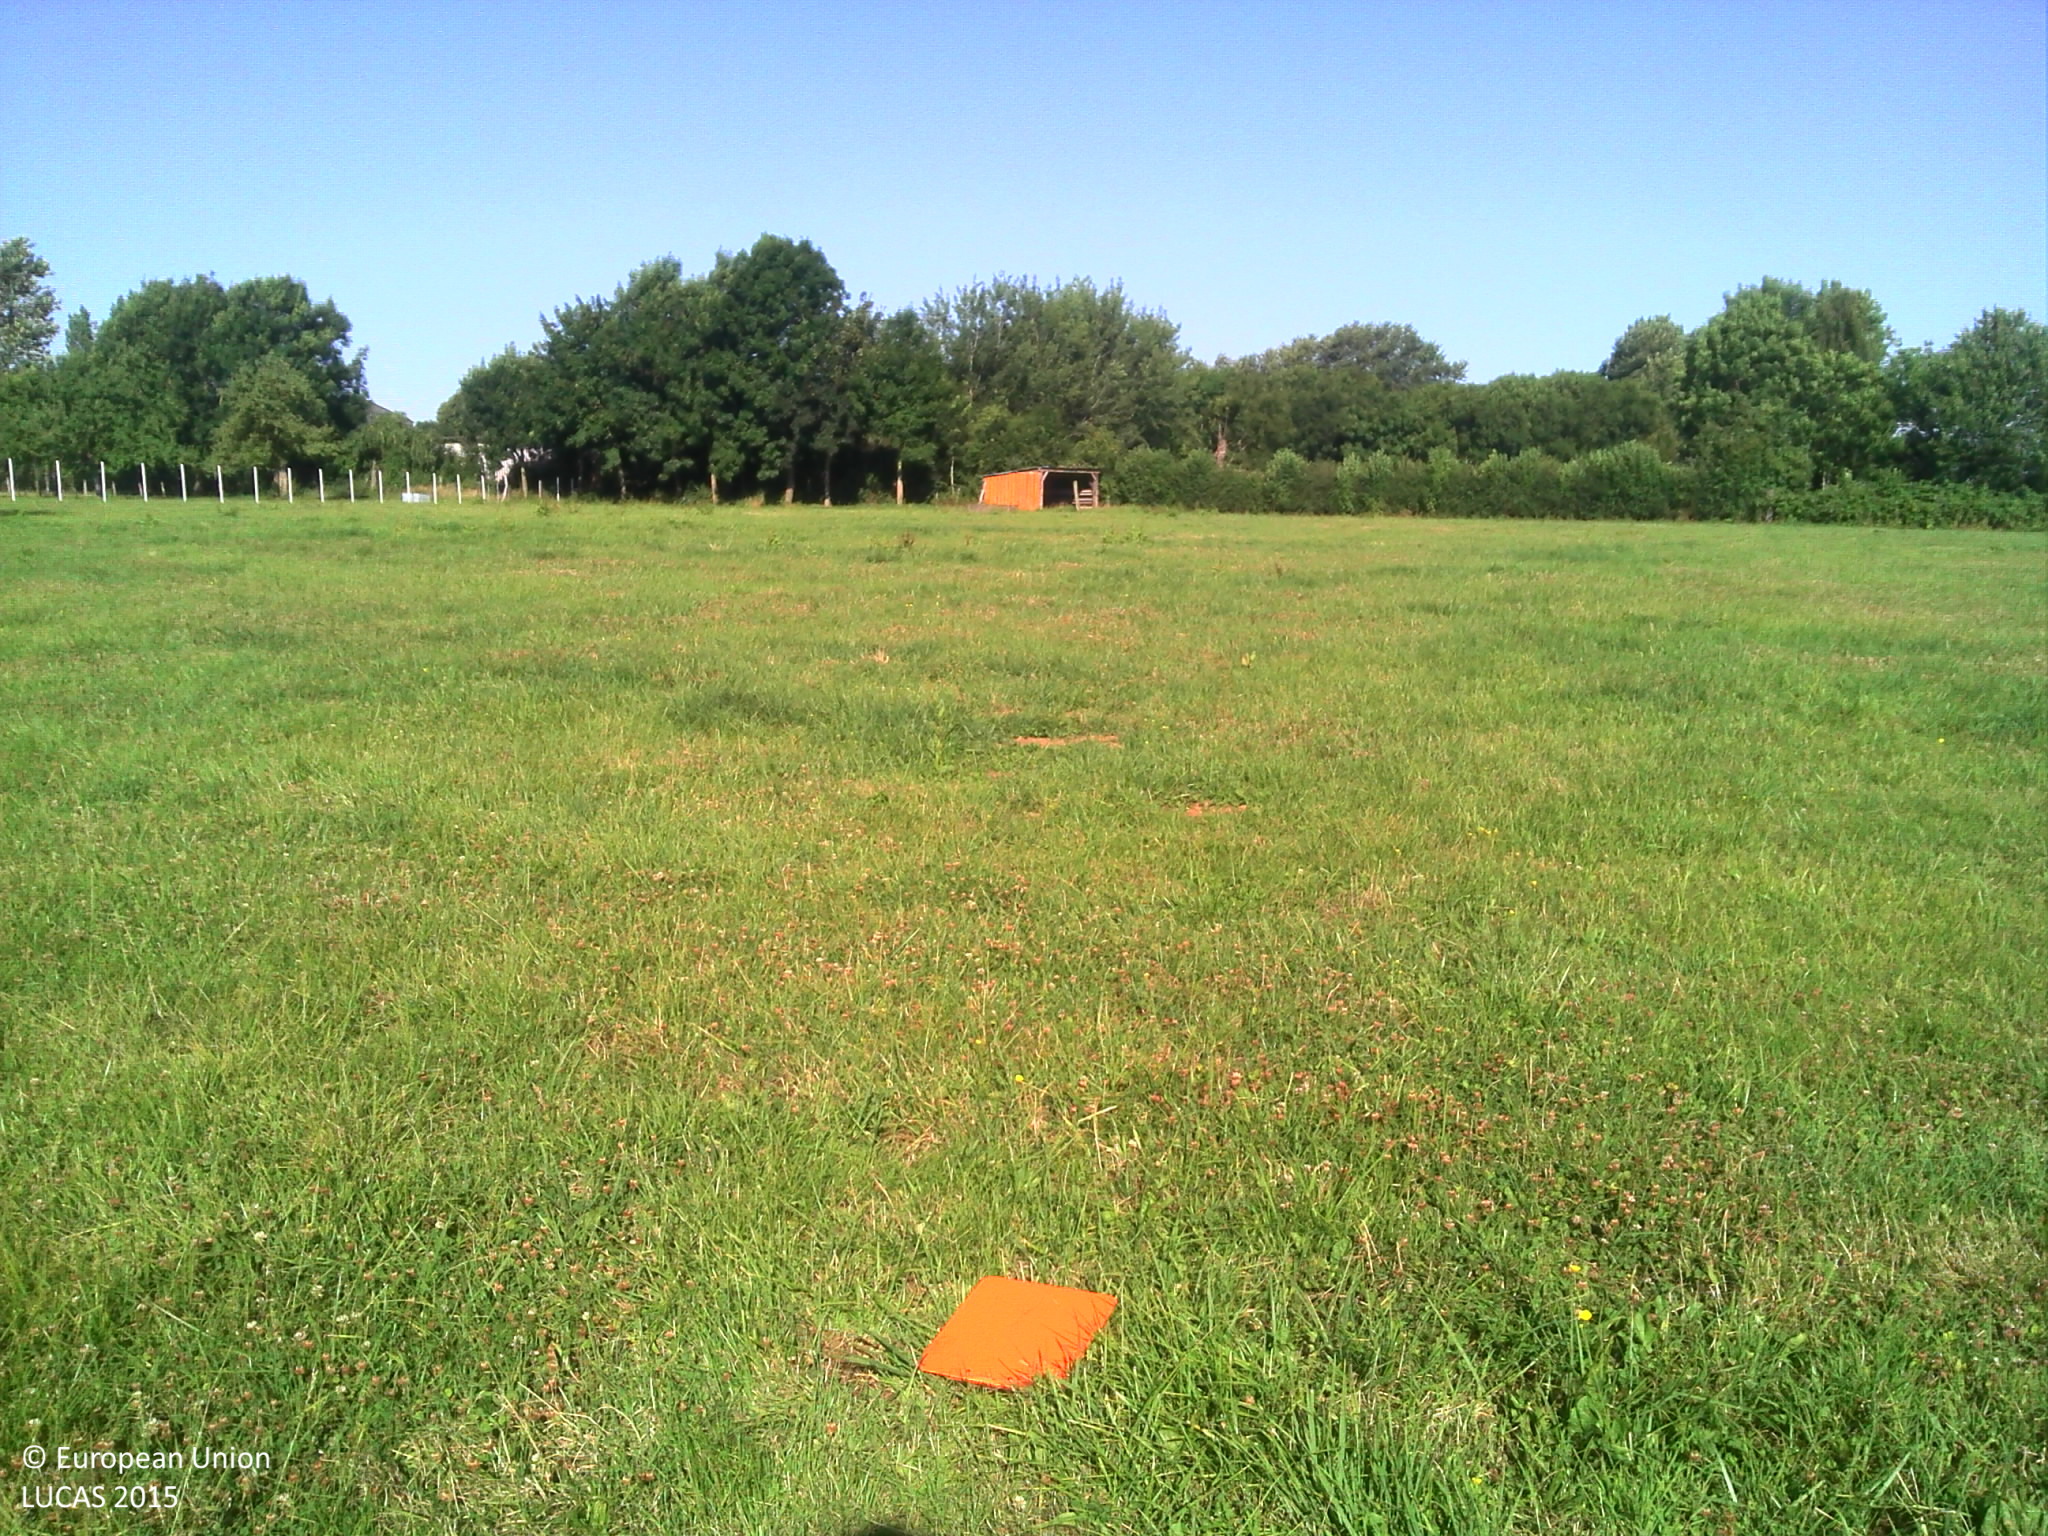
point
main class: Grassland
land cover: Grassland without tree/shrub cover
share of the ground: > 75 %
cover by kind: herbaceous plants 100 %
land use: Agriculture (excluding fallow land and kitchen gardens)
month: July
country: FR
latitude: 49.9727
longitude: 1.7143
